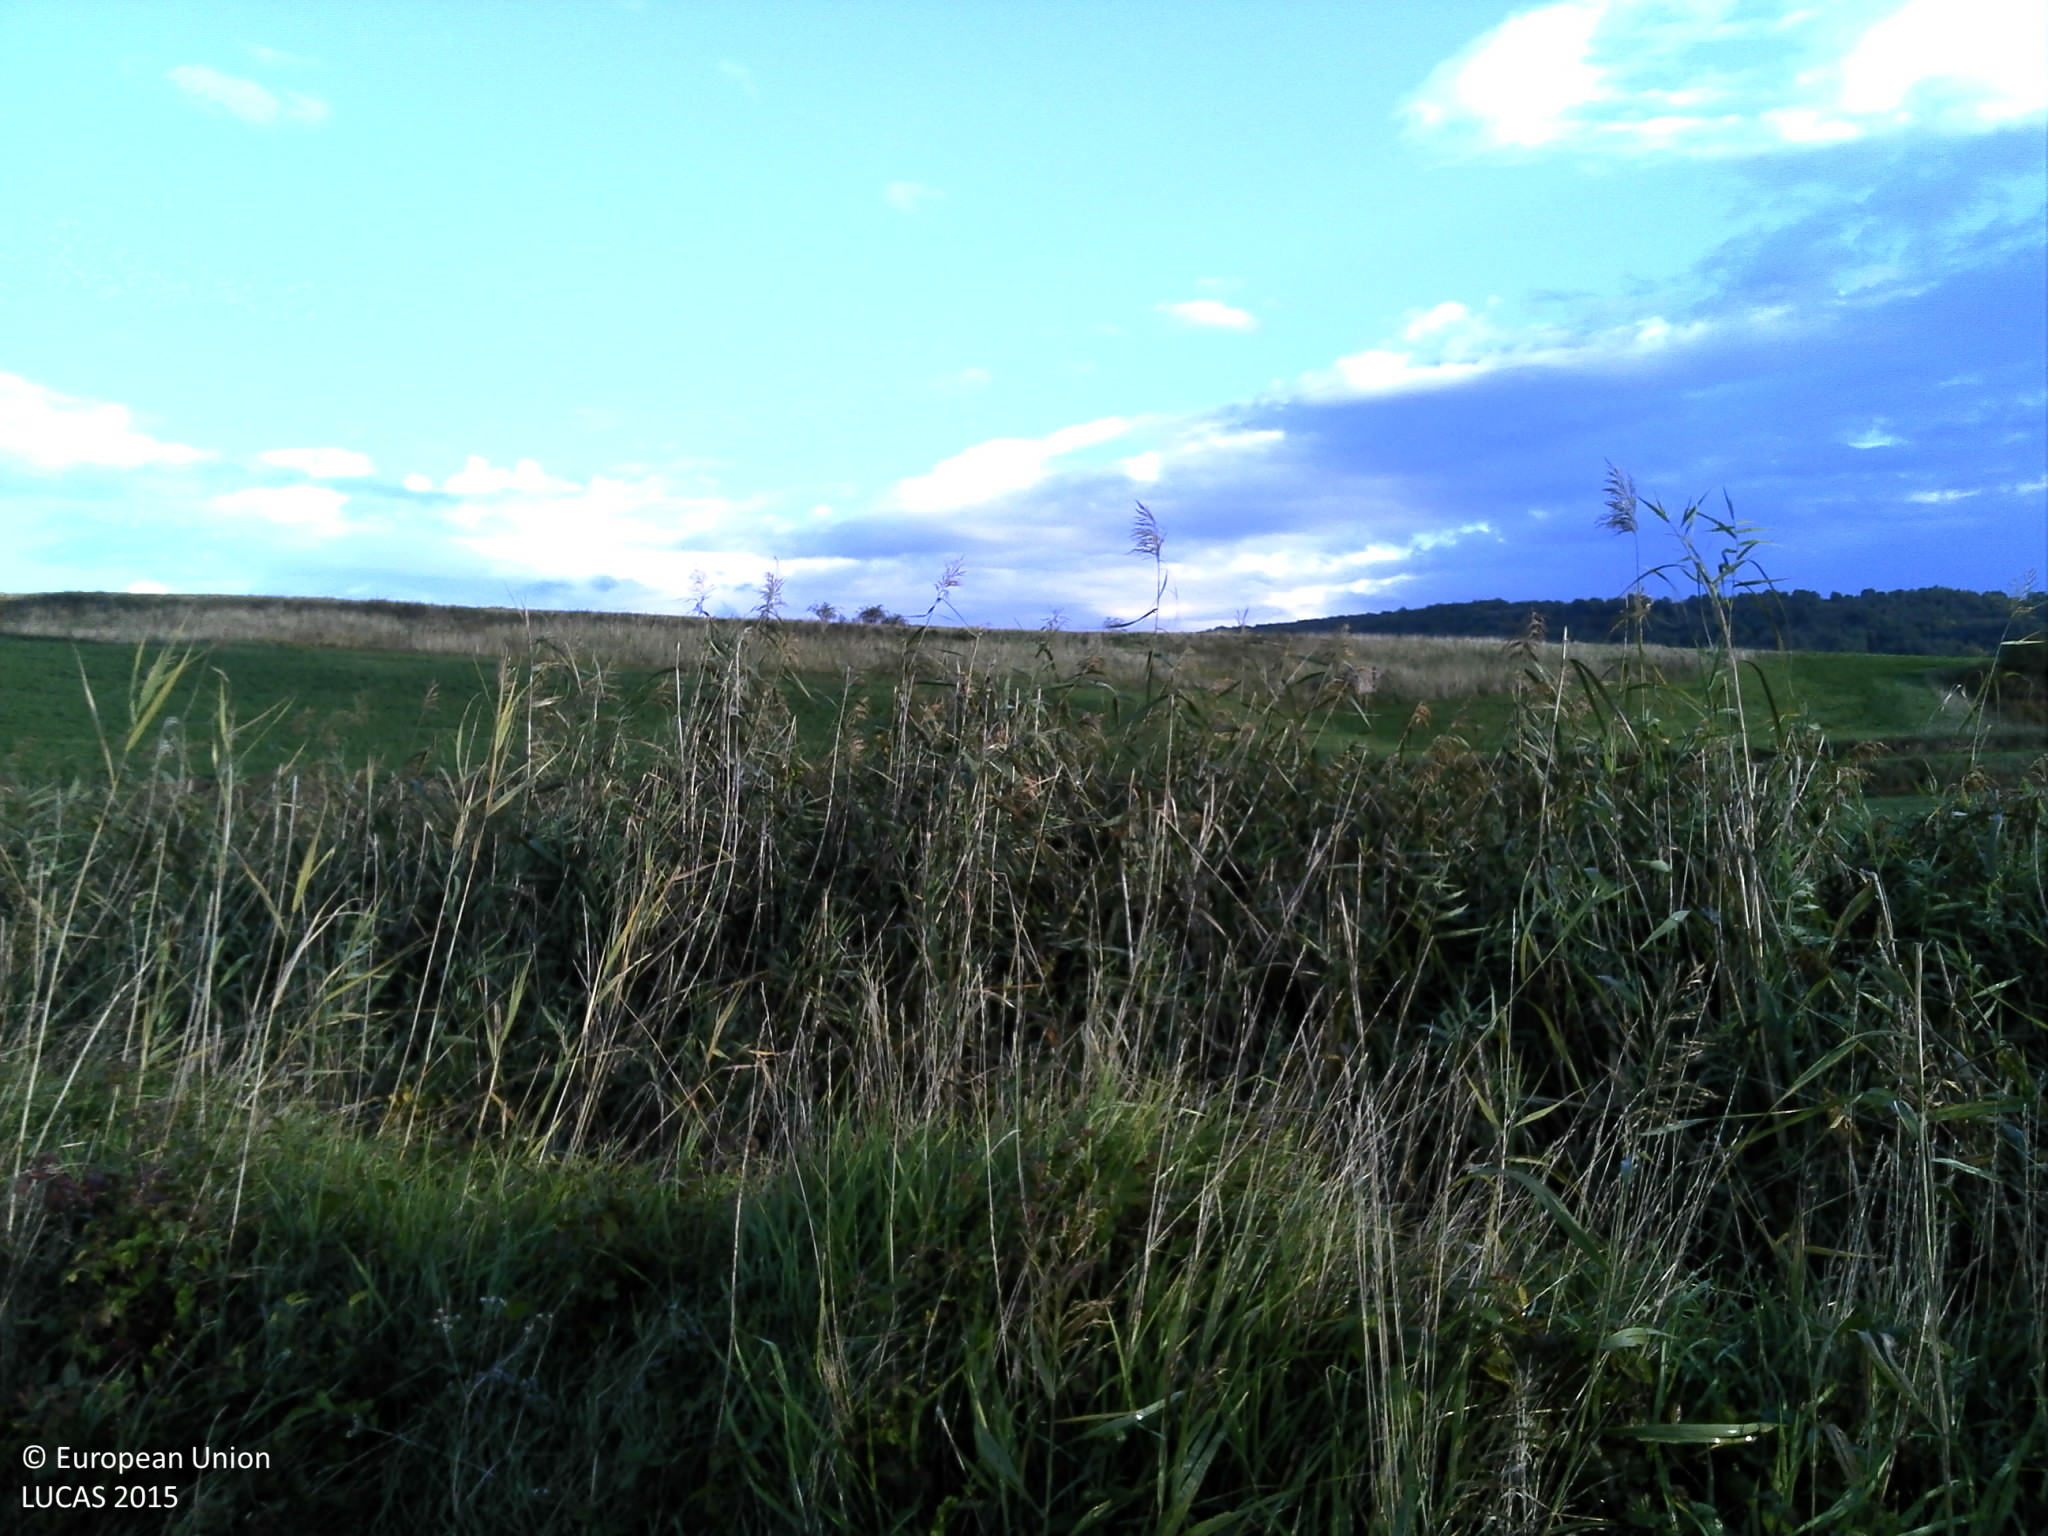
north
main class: Cropland
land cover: Rape and turnip rape
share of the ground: 25 - 50 %
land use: Agriculture (excluding fallow land and kitchen gardens)
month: October
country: FR
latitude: 45.4469
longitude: 3.1864
